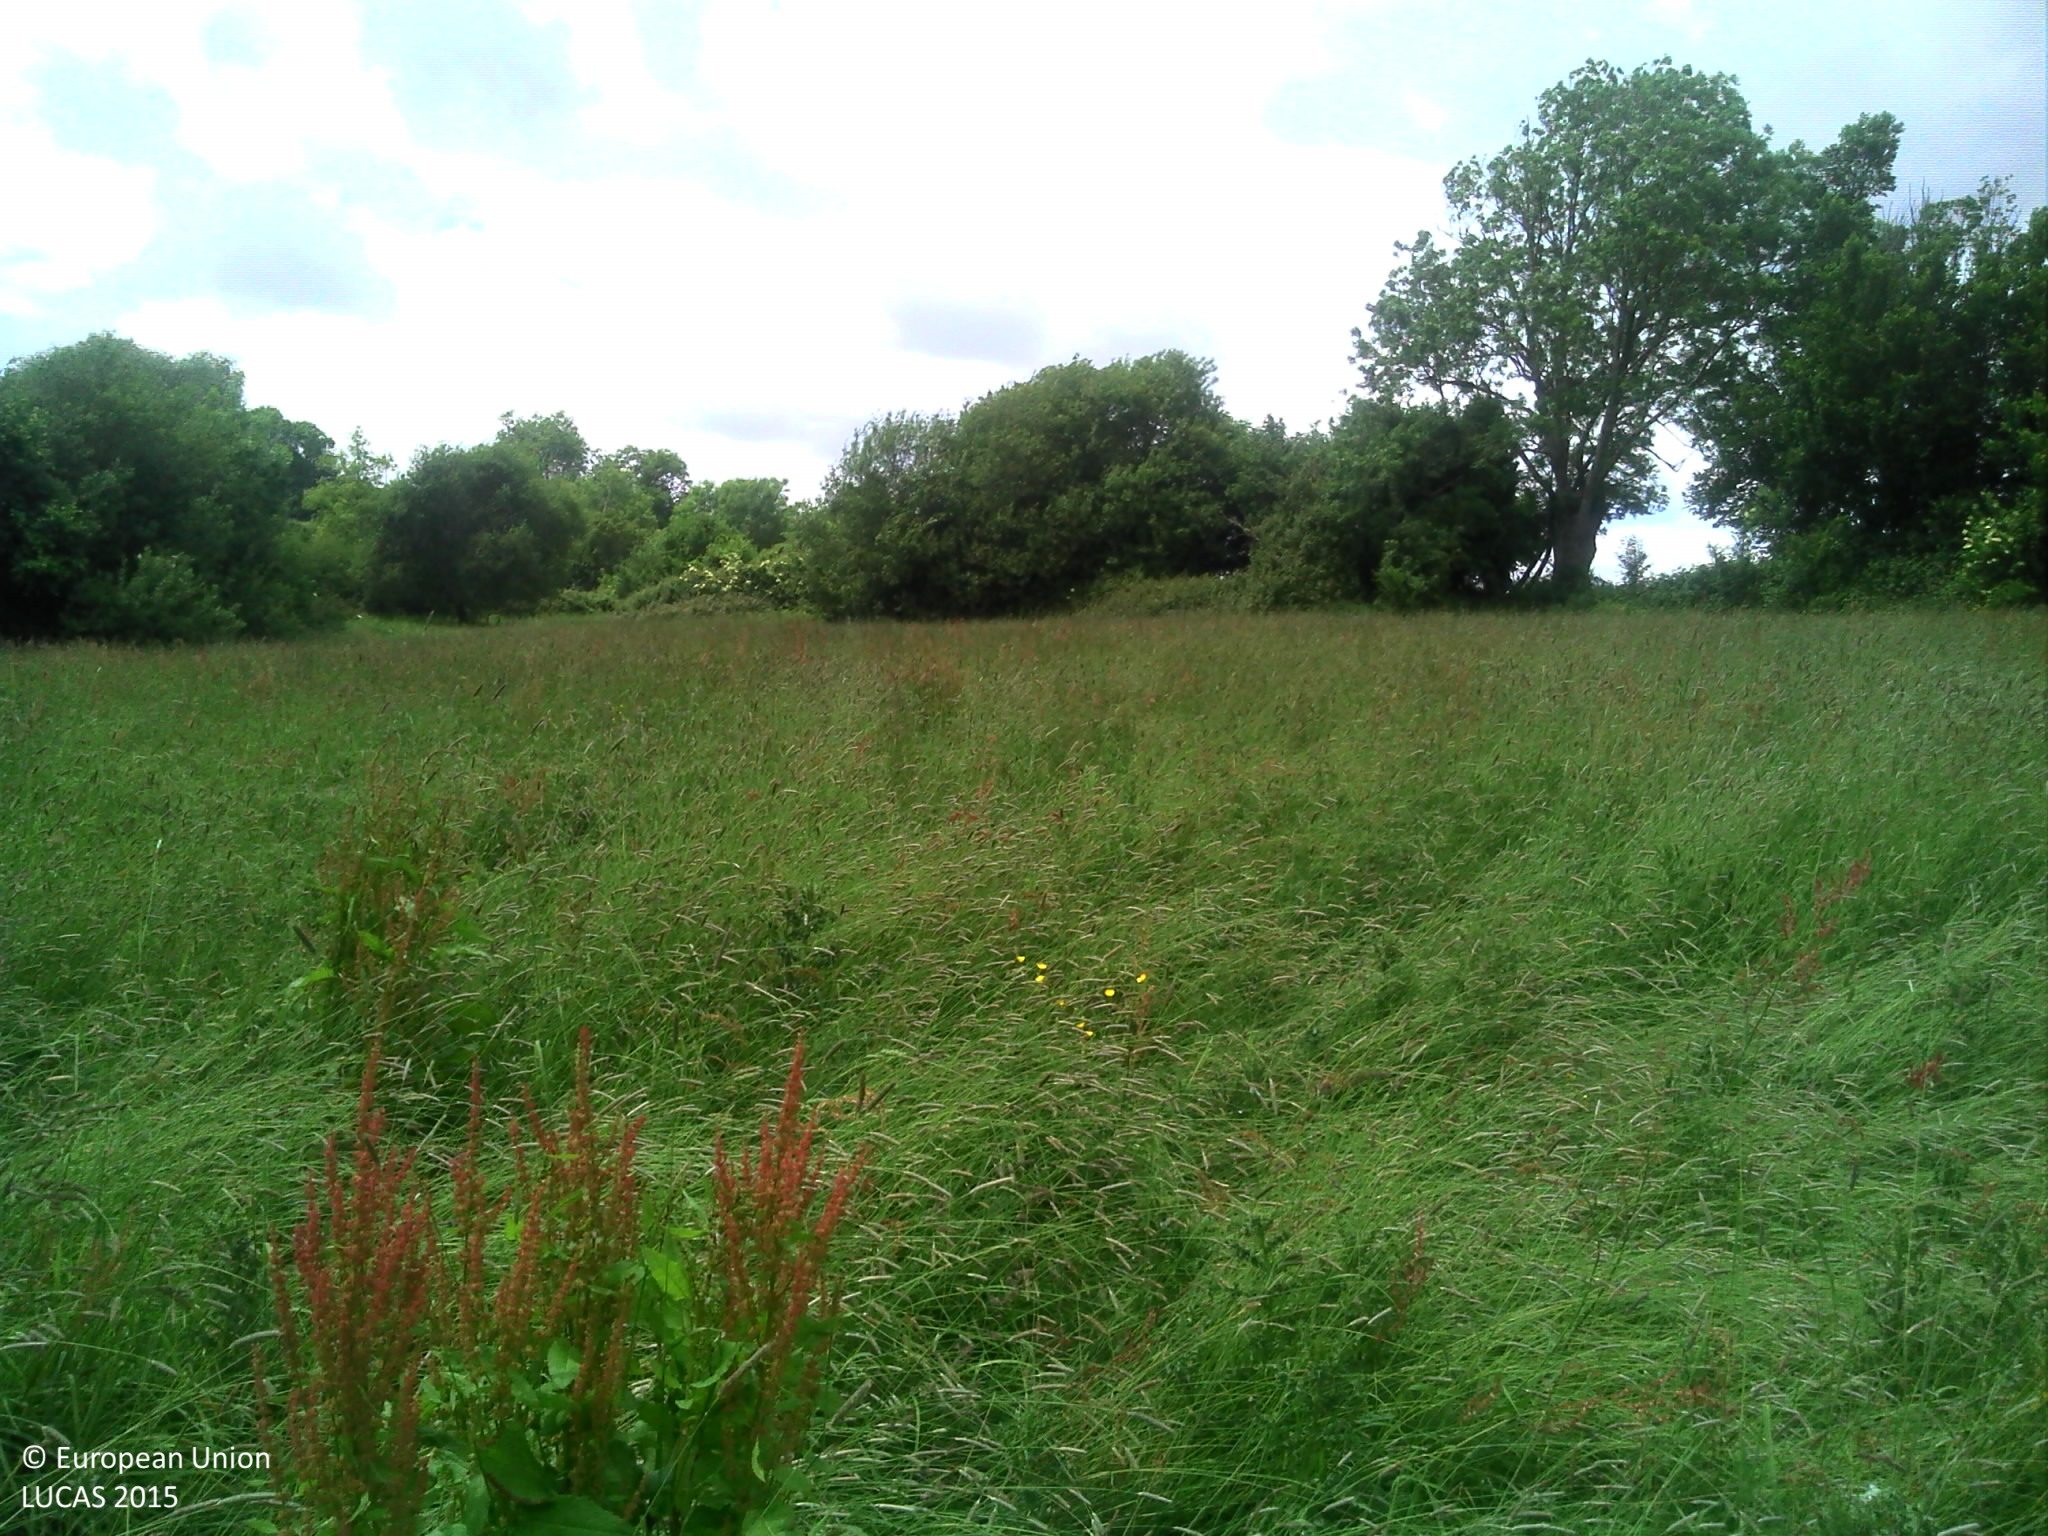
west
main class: Grassland
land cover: Grassland without tree/shrub cover
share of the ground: > 75 %
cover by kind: herbaceous plants 95 %
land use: Agriculture (excluding fallow land and kitchen gardens)
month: June
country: FR
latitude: 48.8989
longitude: 0.0804
